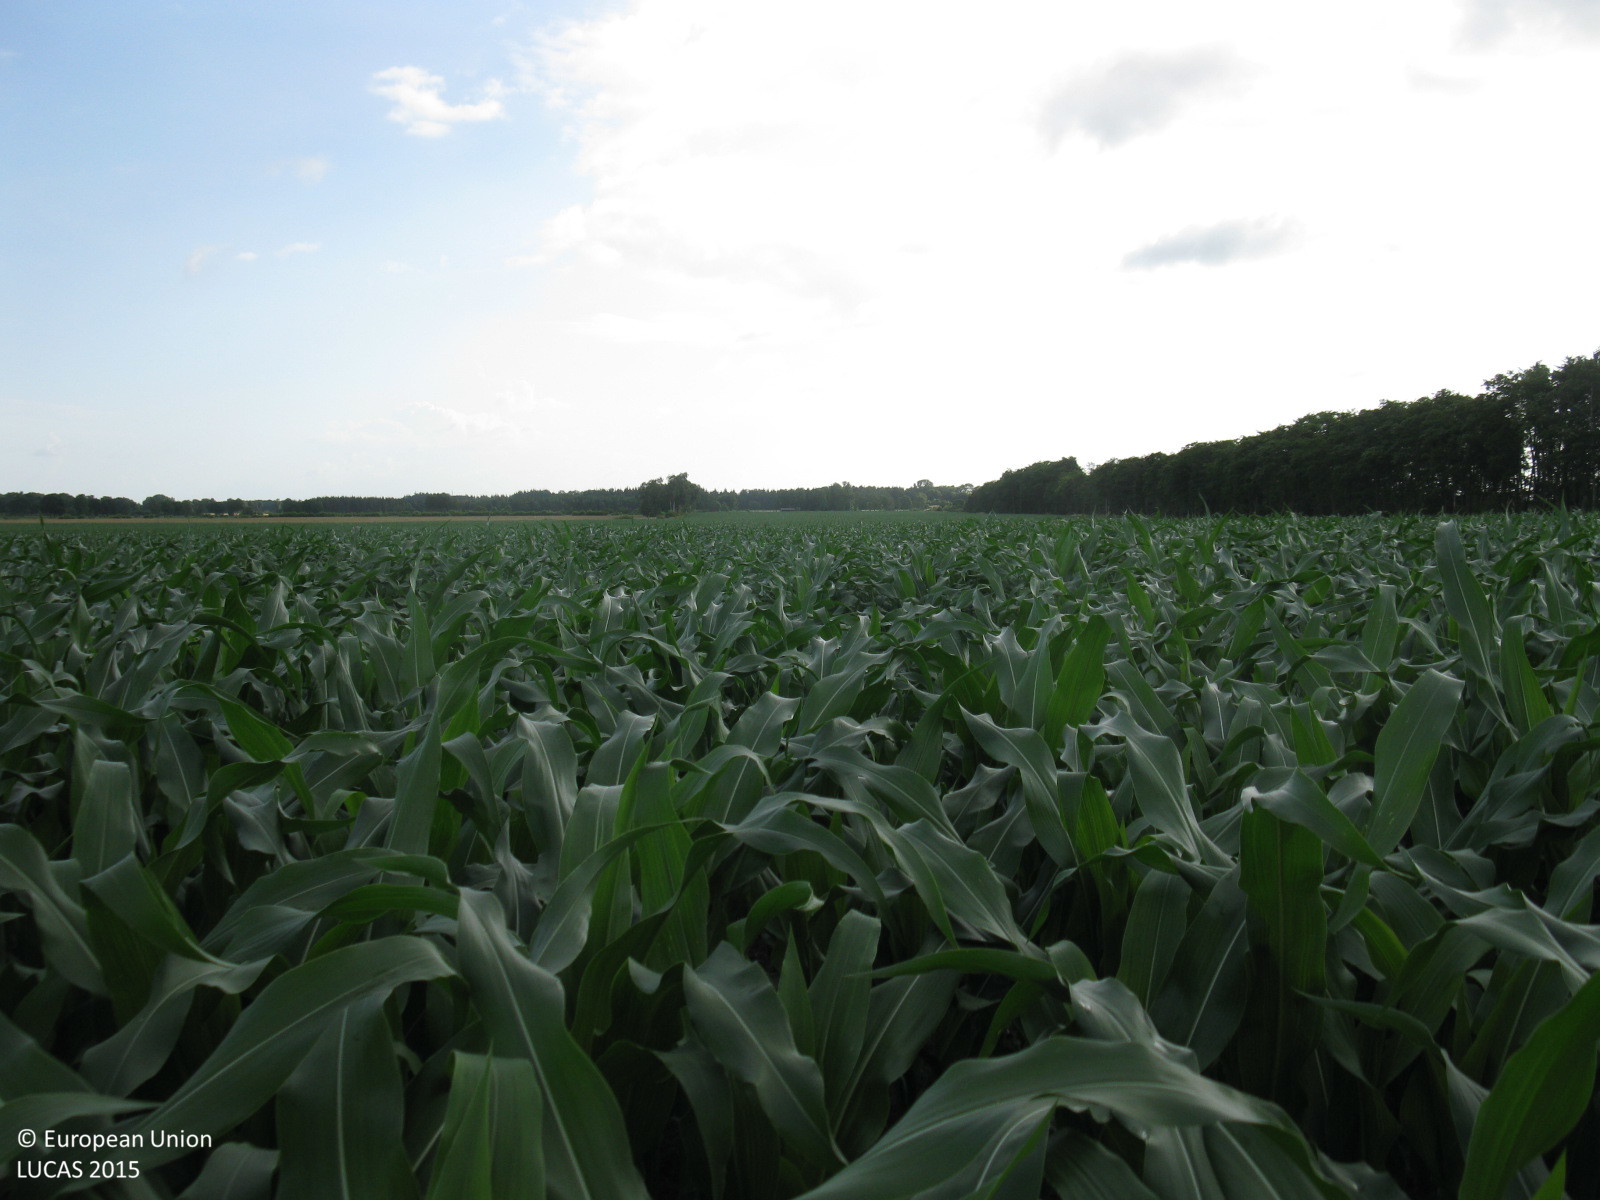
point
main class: Cropland
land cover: Maize
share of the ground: > 75 %
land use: Agriculture (excluding fallow land and kitchen gardens)
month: July
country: DE
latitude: 53.4193
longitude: 7.8791
